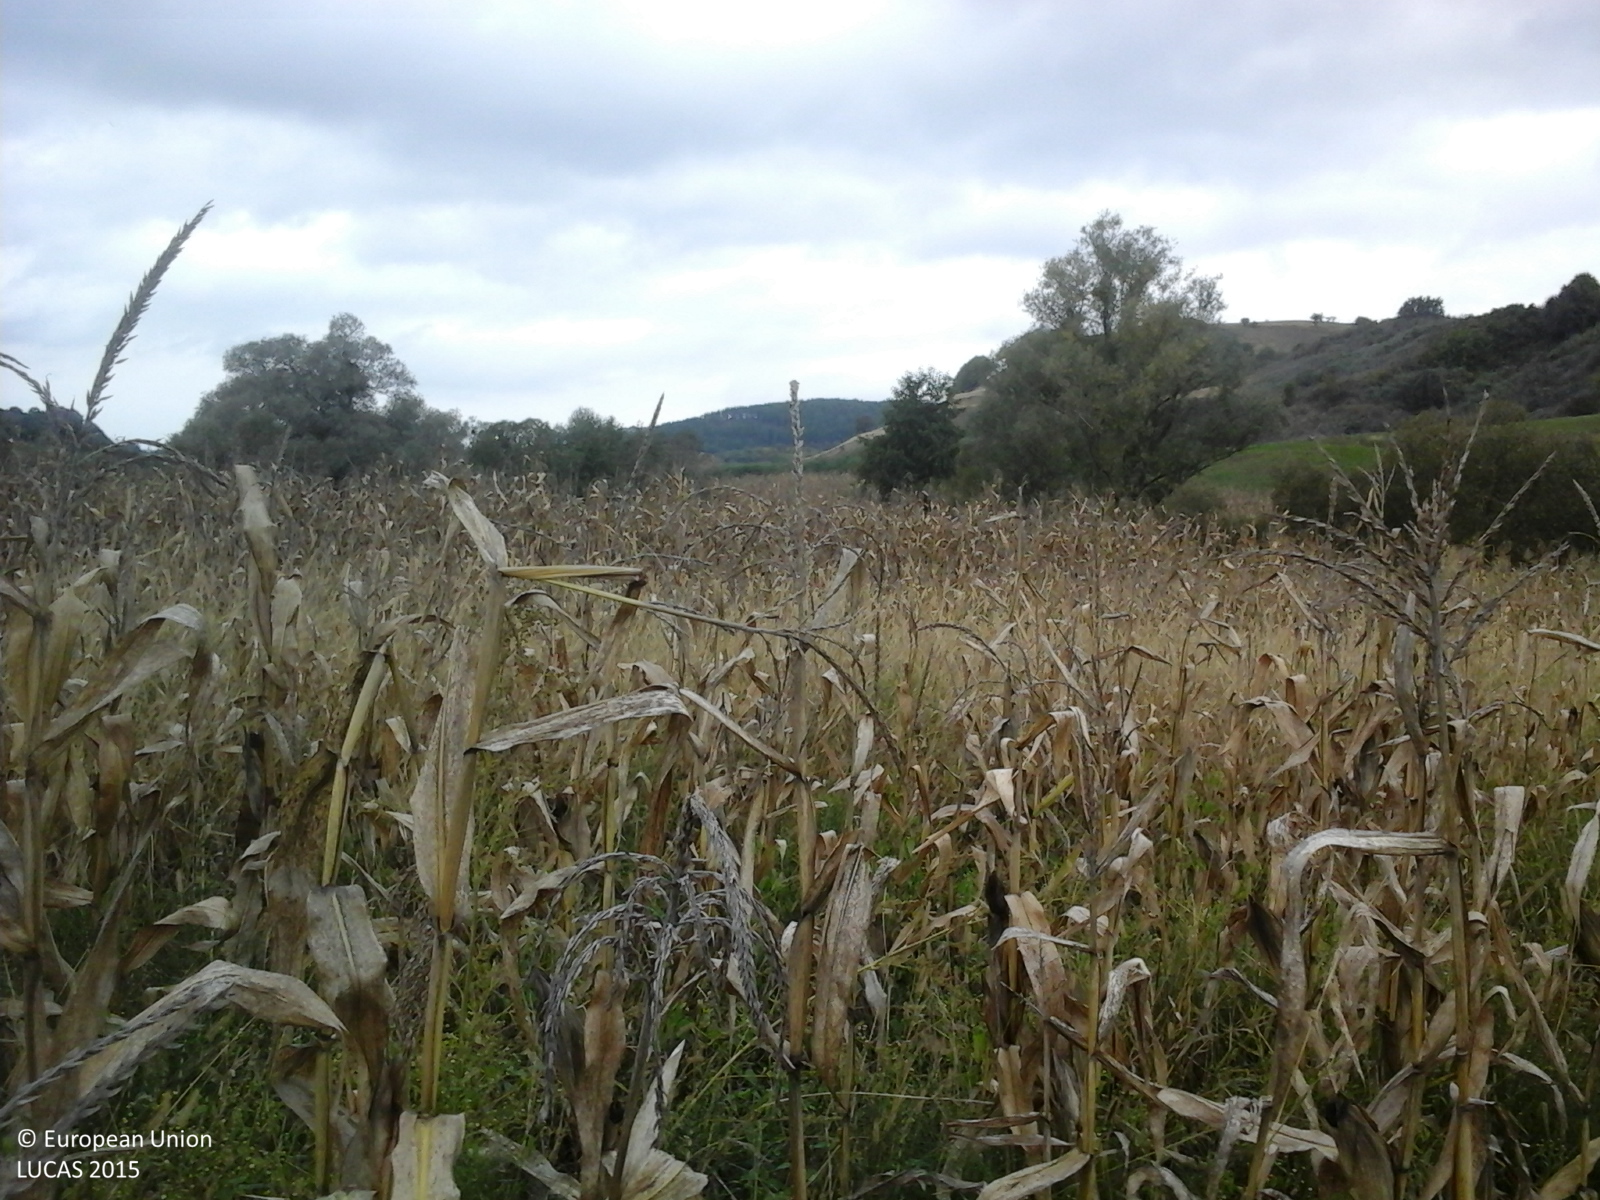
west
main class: Cropland
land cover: Maize
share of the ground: > 75 %
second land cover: Spontaneously vegetated surfaces
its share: 25 - 50 %
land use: Agriculture (excluding fallow land and kitchen gardens)
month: October
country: RO
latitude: 45.9283
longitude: 24.1976
